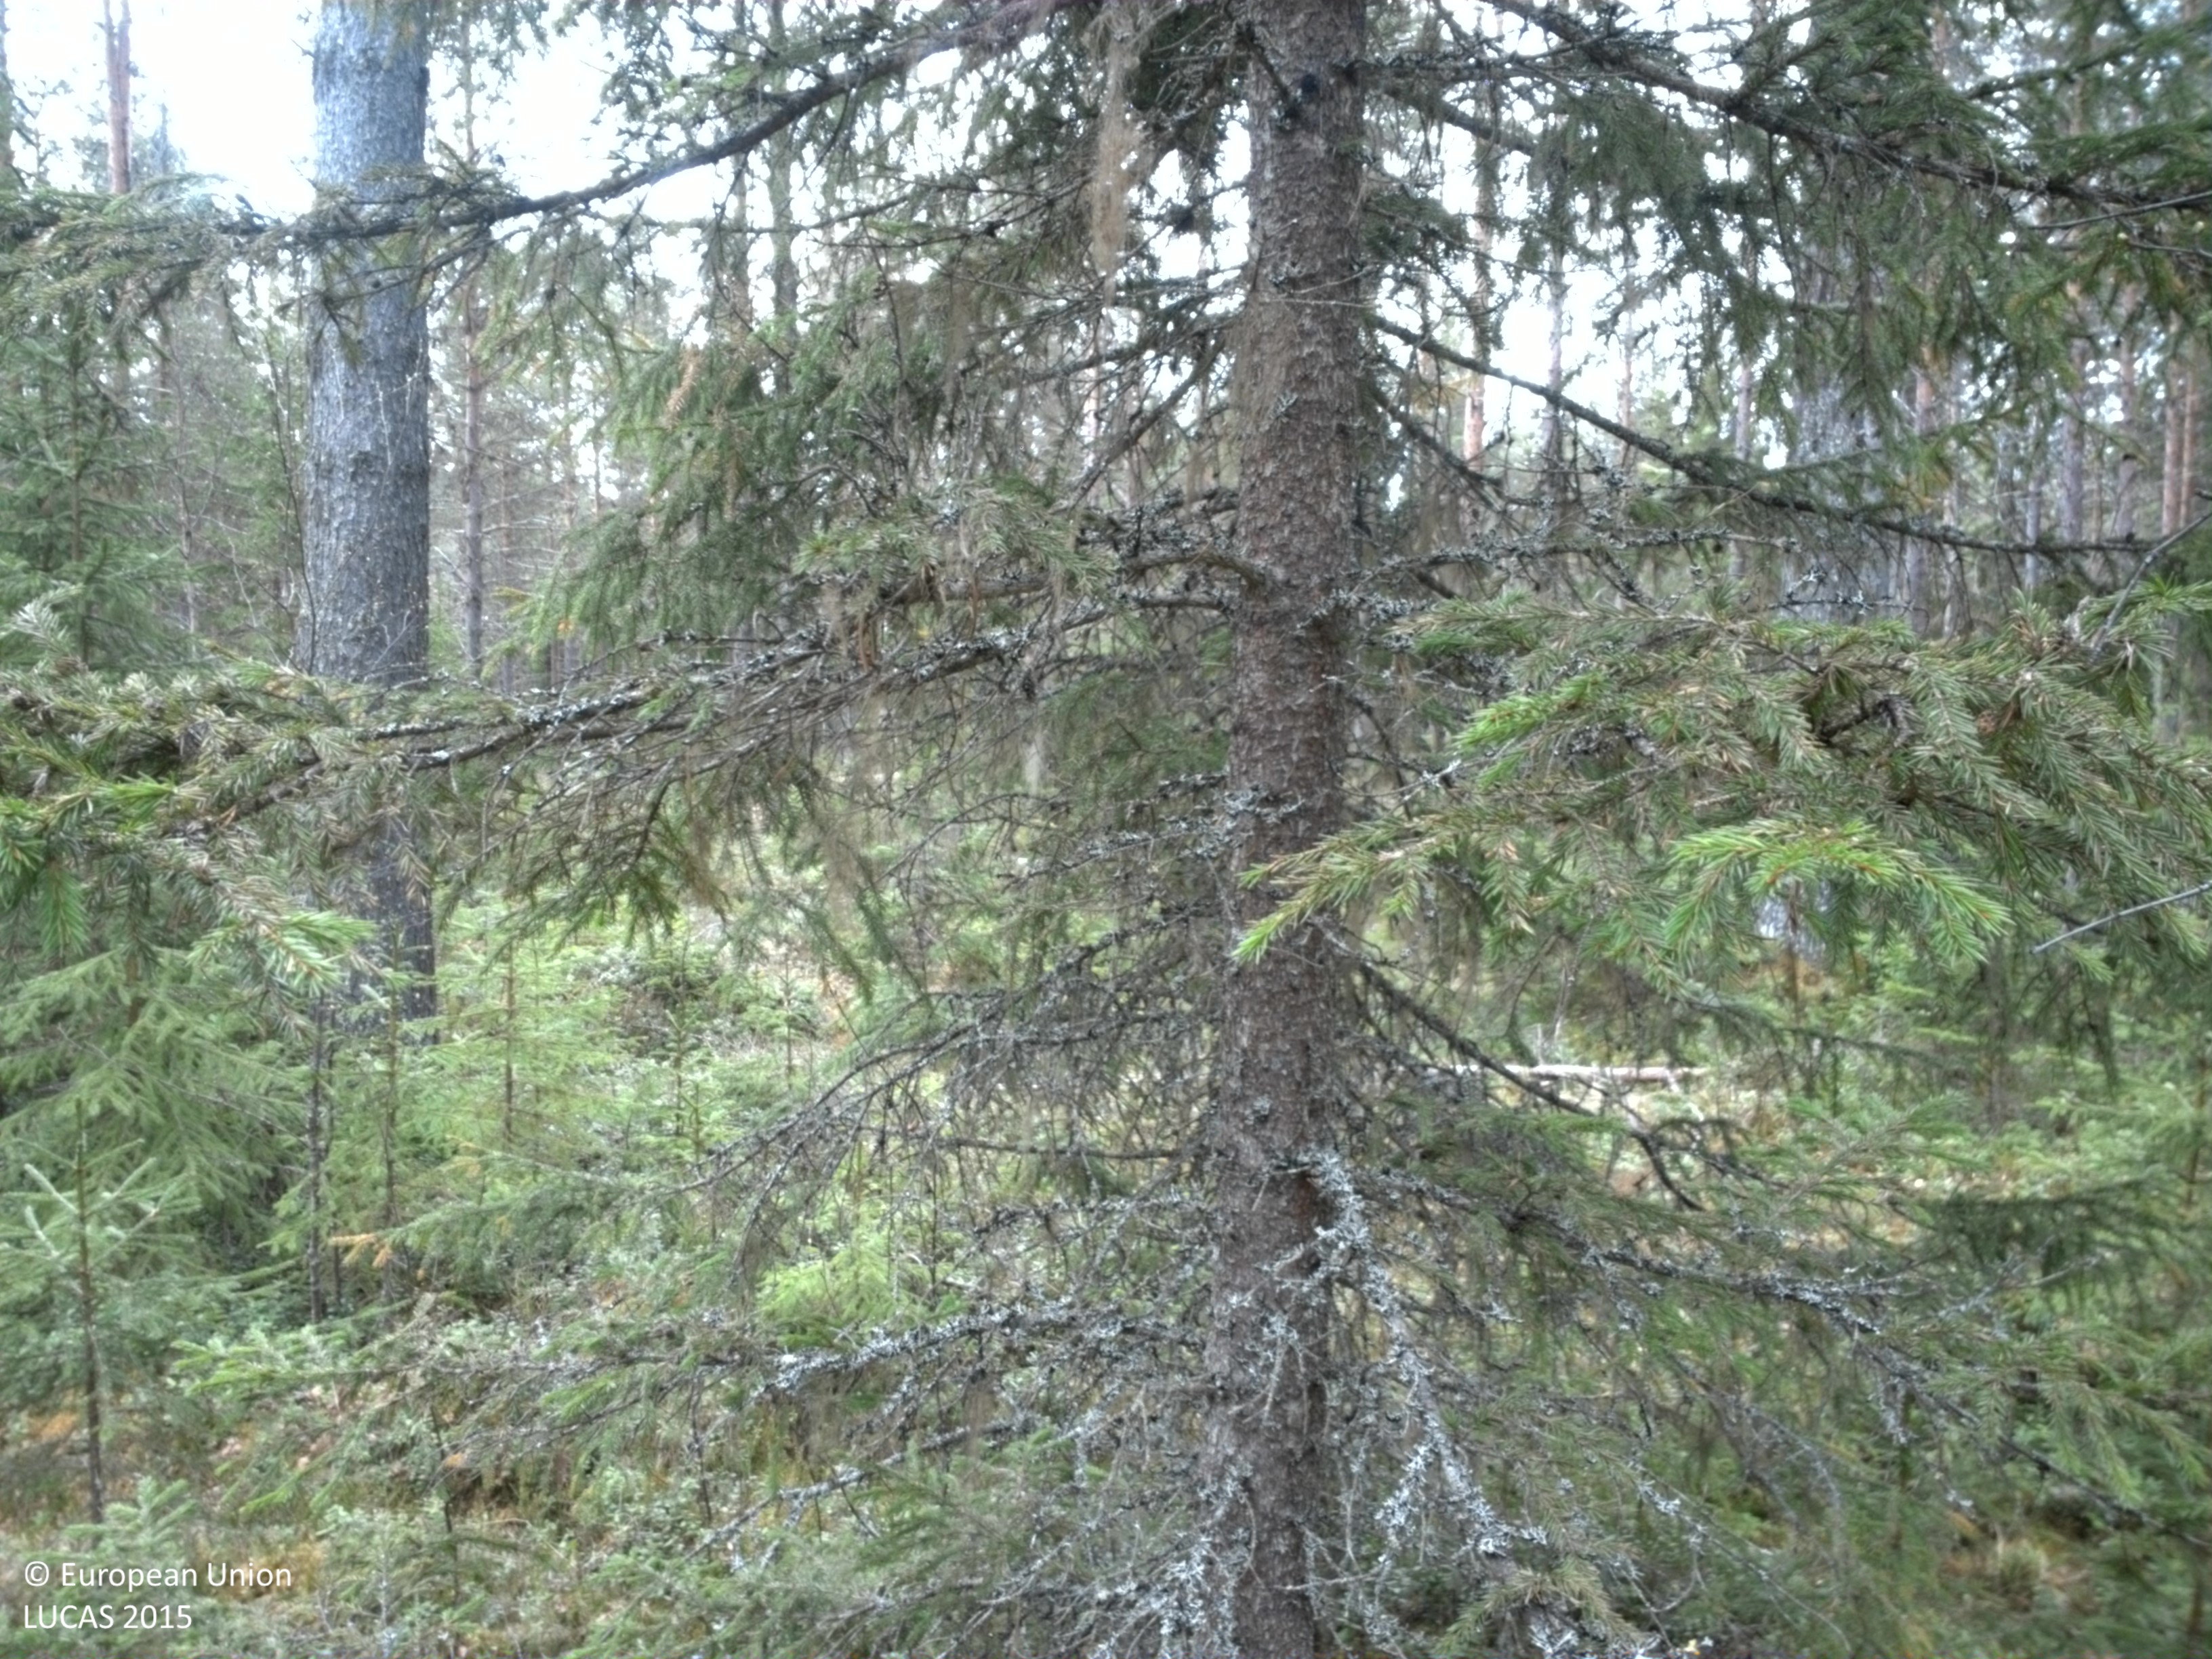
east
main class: Woodland
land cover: Spruce dominated coniferous woodland
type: boreal forest
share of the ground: > 75 %
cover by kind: coniferous forest trees 70 %, shrubs 25 %, broadleaved forest trees 5 %
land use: Forestry
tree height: > 5 m
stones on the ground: < 10 %
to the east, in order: Spruce dominated coniferous woodland; Pine dominated coniferous woodland; Ditches and canals; Paved roads, cycling and walking lanes; Pine dominated coniferous woodland; Spruce dominated coniferous woodland; Pine dominated coniferous woodland; Pine dominated mixed woodland
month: May
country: SE
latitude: 62.7419
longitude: 15.1265
